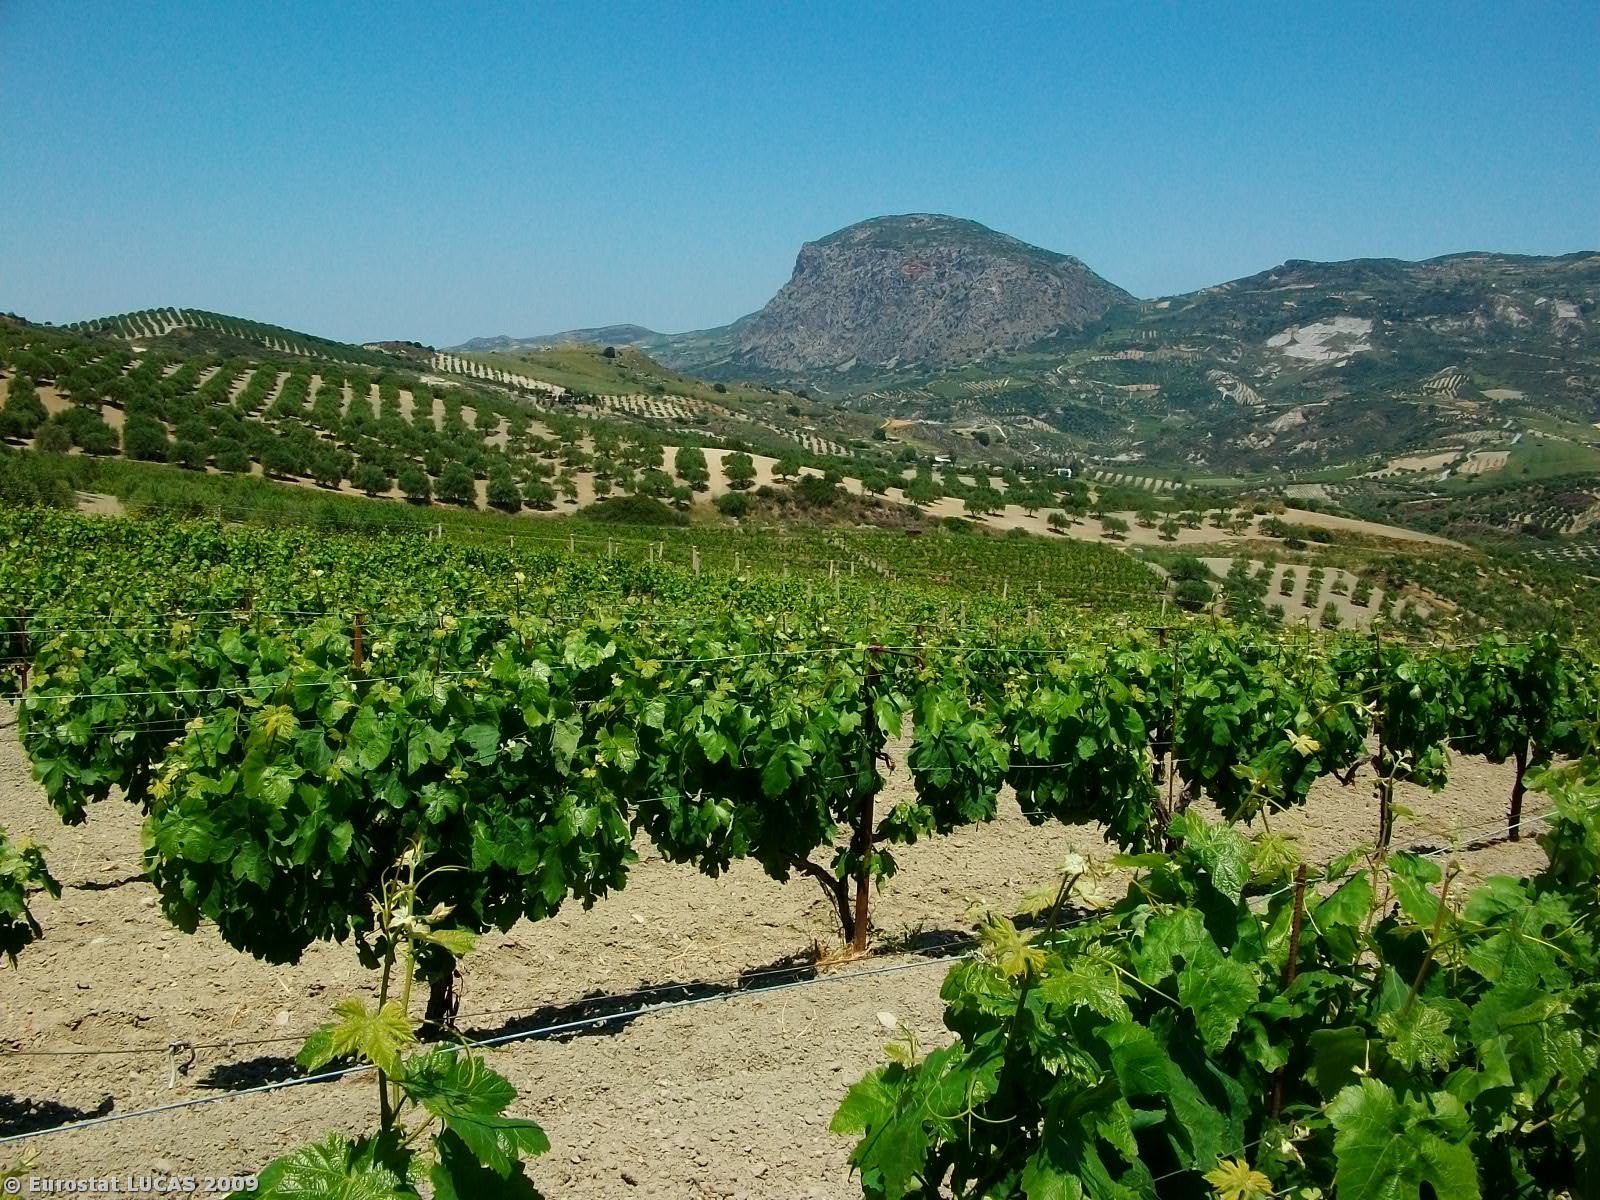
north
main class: Cropland
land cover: Vineyards
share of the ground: 25 - 50 %
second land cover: Bare land
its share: > 75 %
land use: Agriculture (excluding fallow land and kitchen gardens)
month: May
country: GR
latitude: 35.1834
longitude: 25.1334
